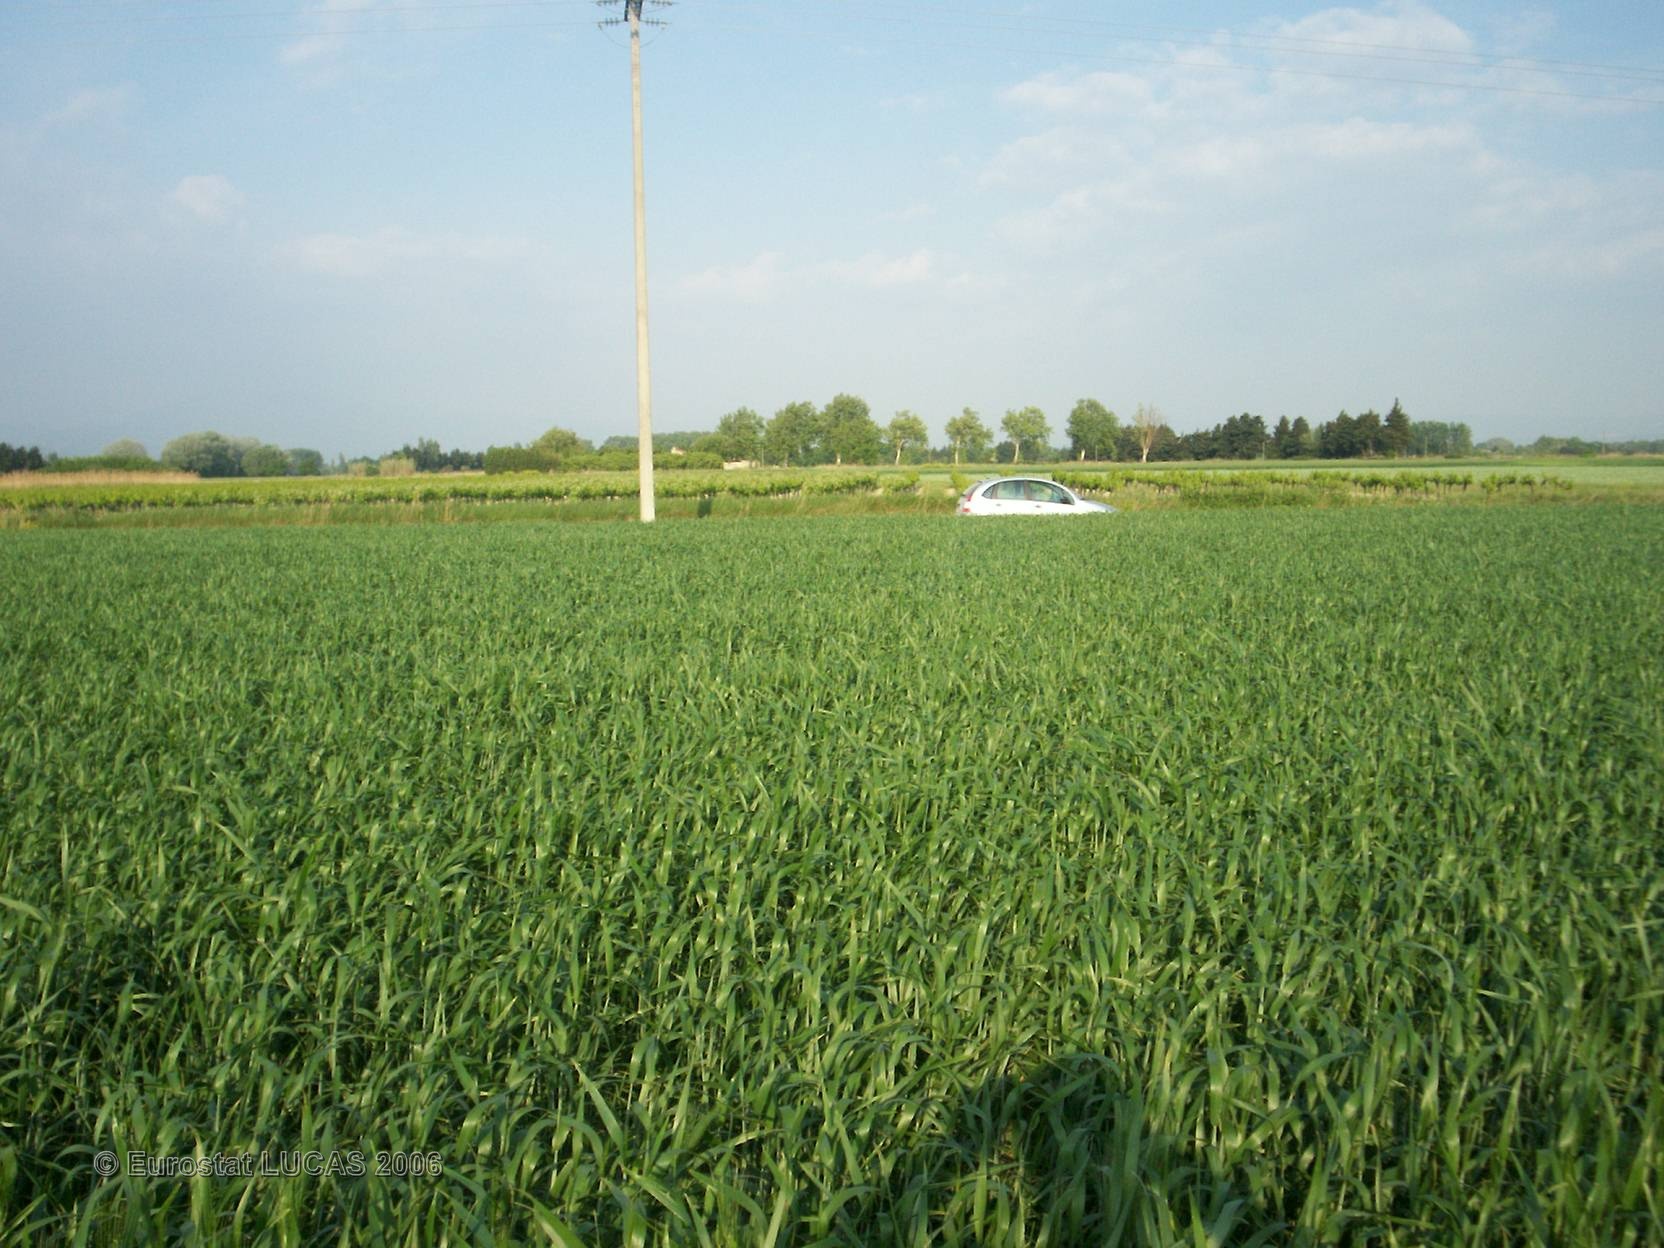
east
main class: Cropland
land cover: Durum wheat
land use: Agriculture (excluding fallow land and kitchen gardens)
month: May
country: FR
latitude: 44.0626
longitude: 4.9023
